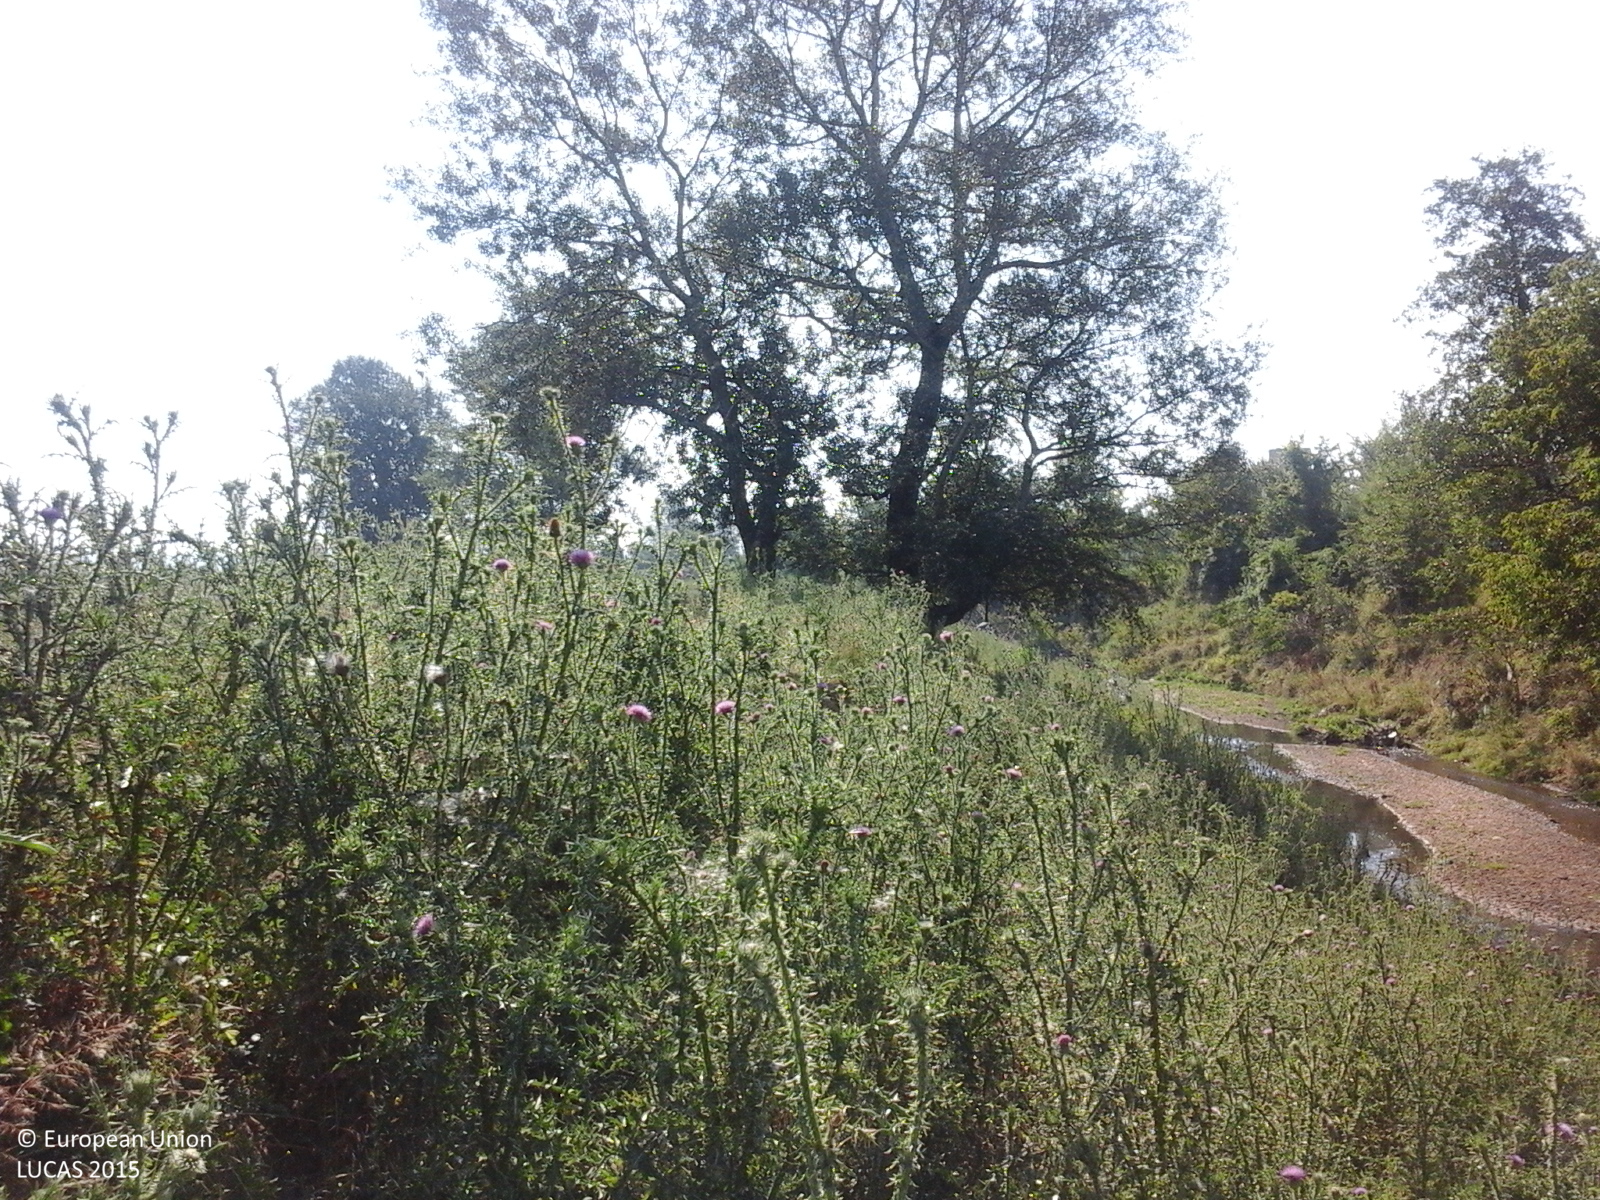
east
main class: Grassland
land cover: Spontaneously vegetated surfaces
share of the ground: > 75 %
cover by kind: herbaceous plants 100 %
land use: Semi-natural and natural areas not in use
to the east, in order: Spontaneously vegetated surfaces; Ditches and canals; Spontaneously vegetated surfaces; Single bushes/trees; Spontaneously vegetated surfaces; Rocks and stones; Inland fresh running water; Rocks and stones; Spontaneously vegetated surfaces; Grassland without tree/shrub cover
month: July
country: RO
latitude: 44.8891
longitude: 24.8317
